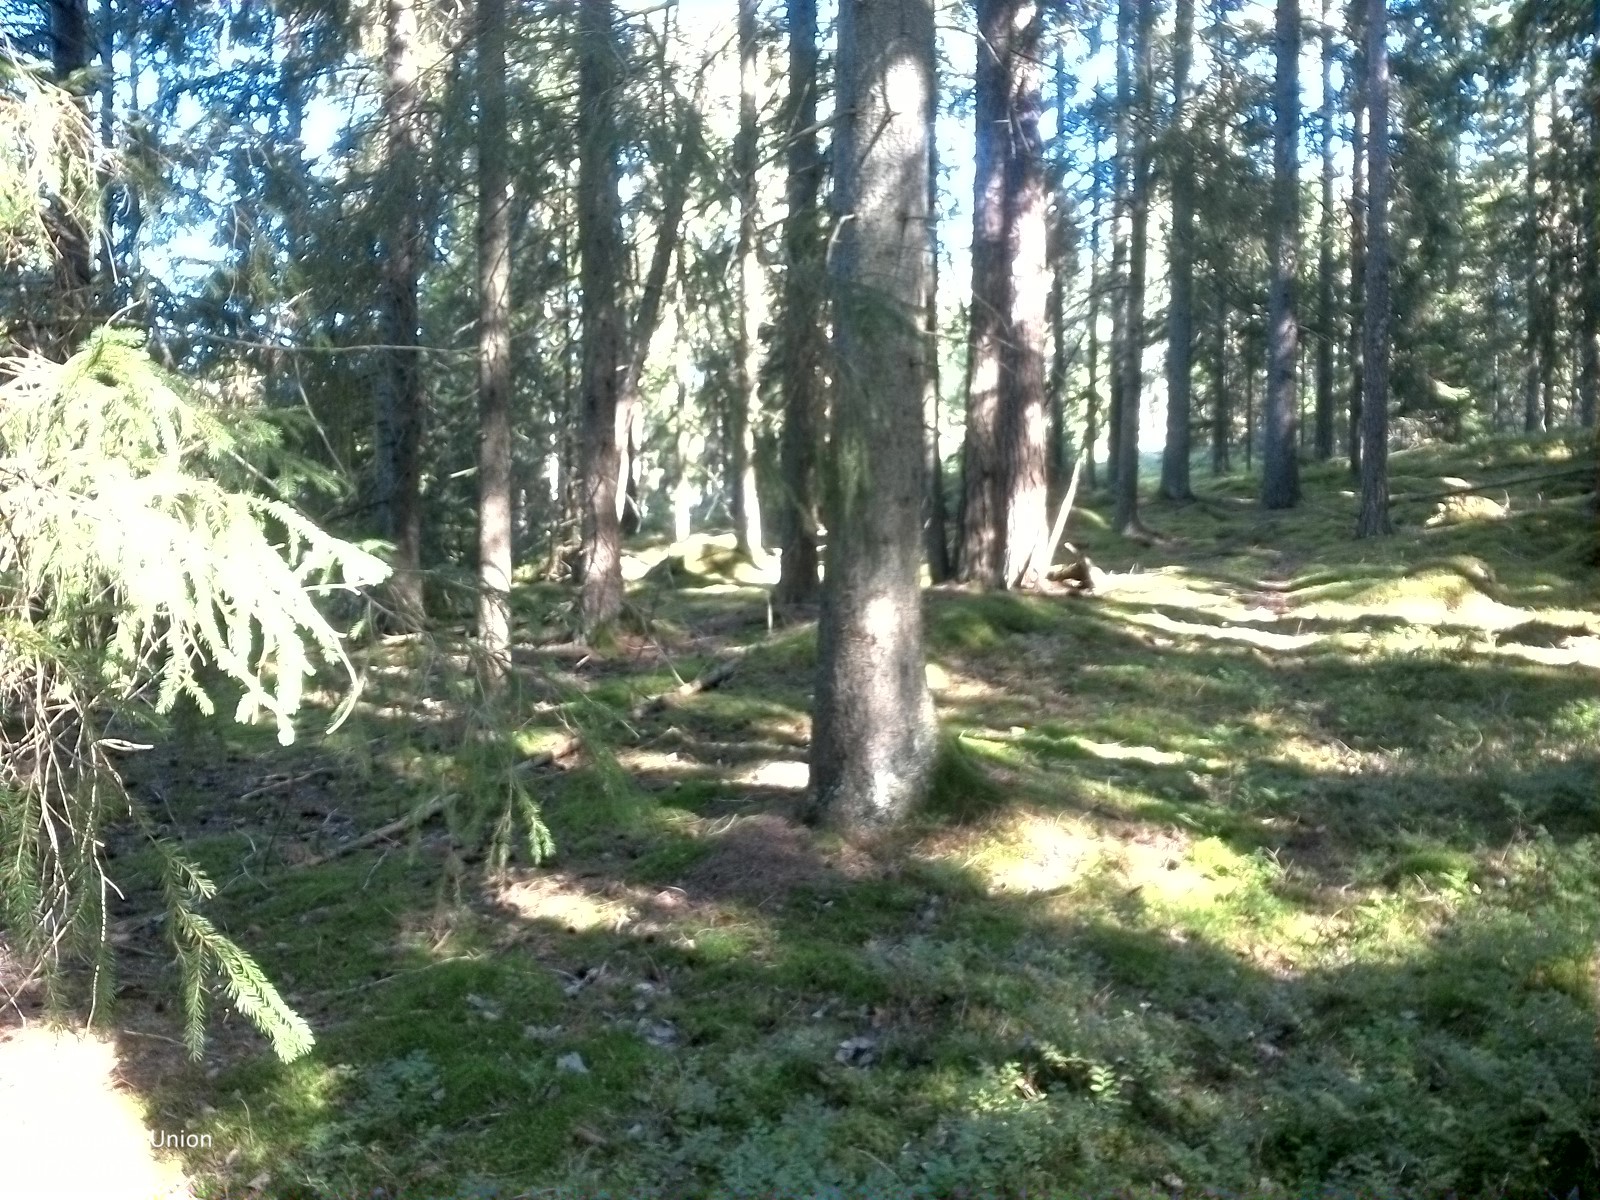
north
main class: Woodland
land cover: Spruce dominated coniferous woodland
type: boreal forest
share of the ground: 50 - 75 %
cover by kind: coniferous forest trees 55 %, lichens and mosses 30 %, herbaceous plants 15 %
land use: Forestry
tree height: > 5 m
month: August
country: SE
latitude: 59.4011
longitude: 15.1518
